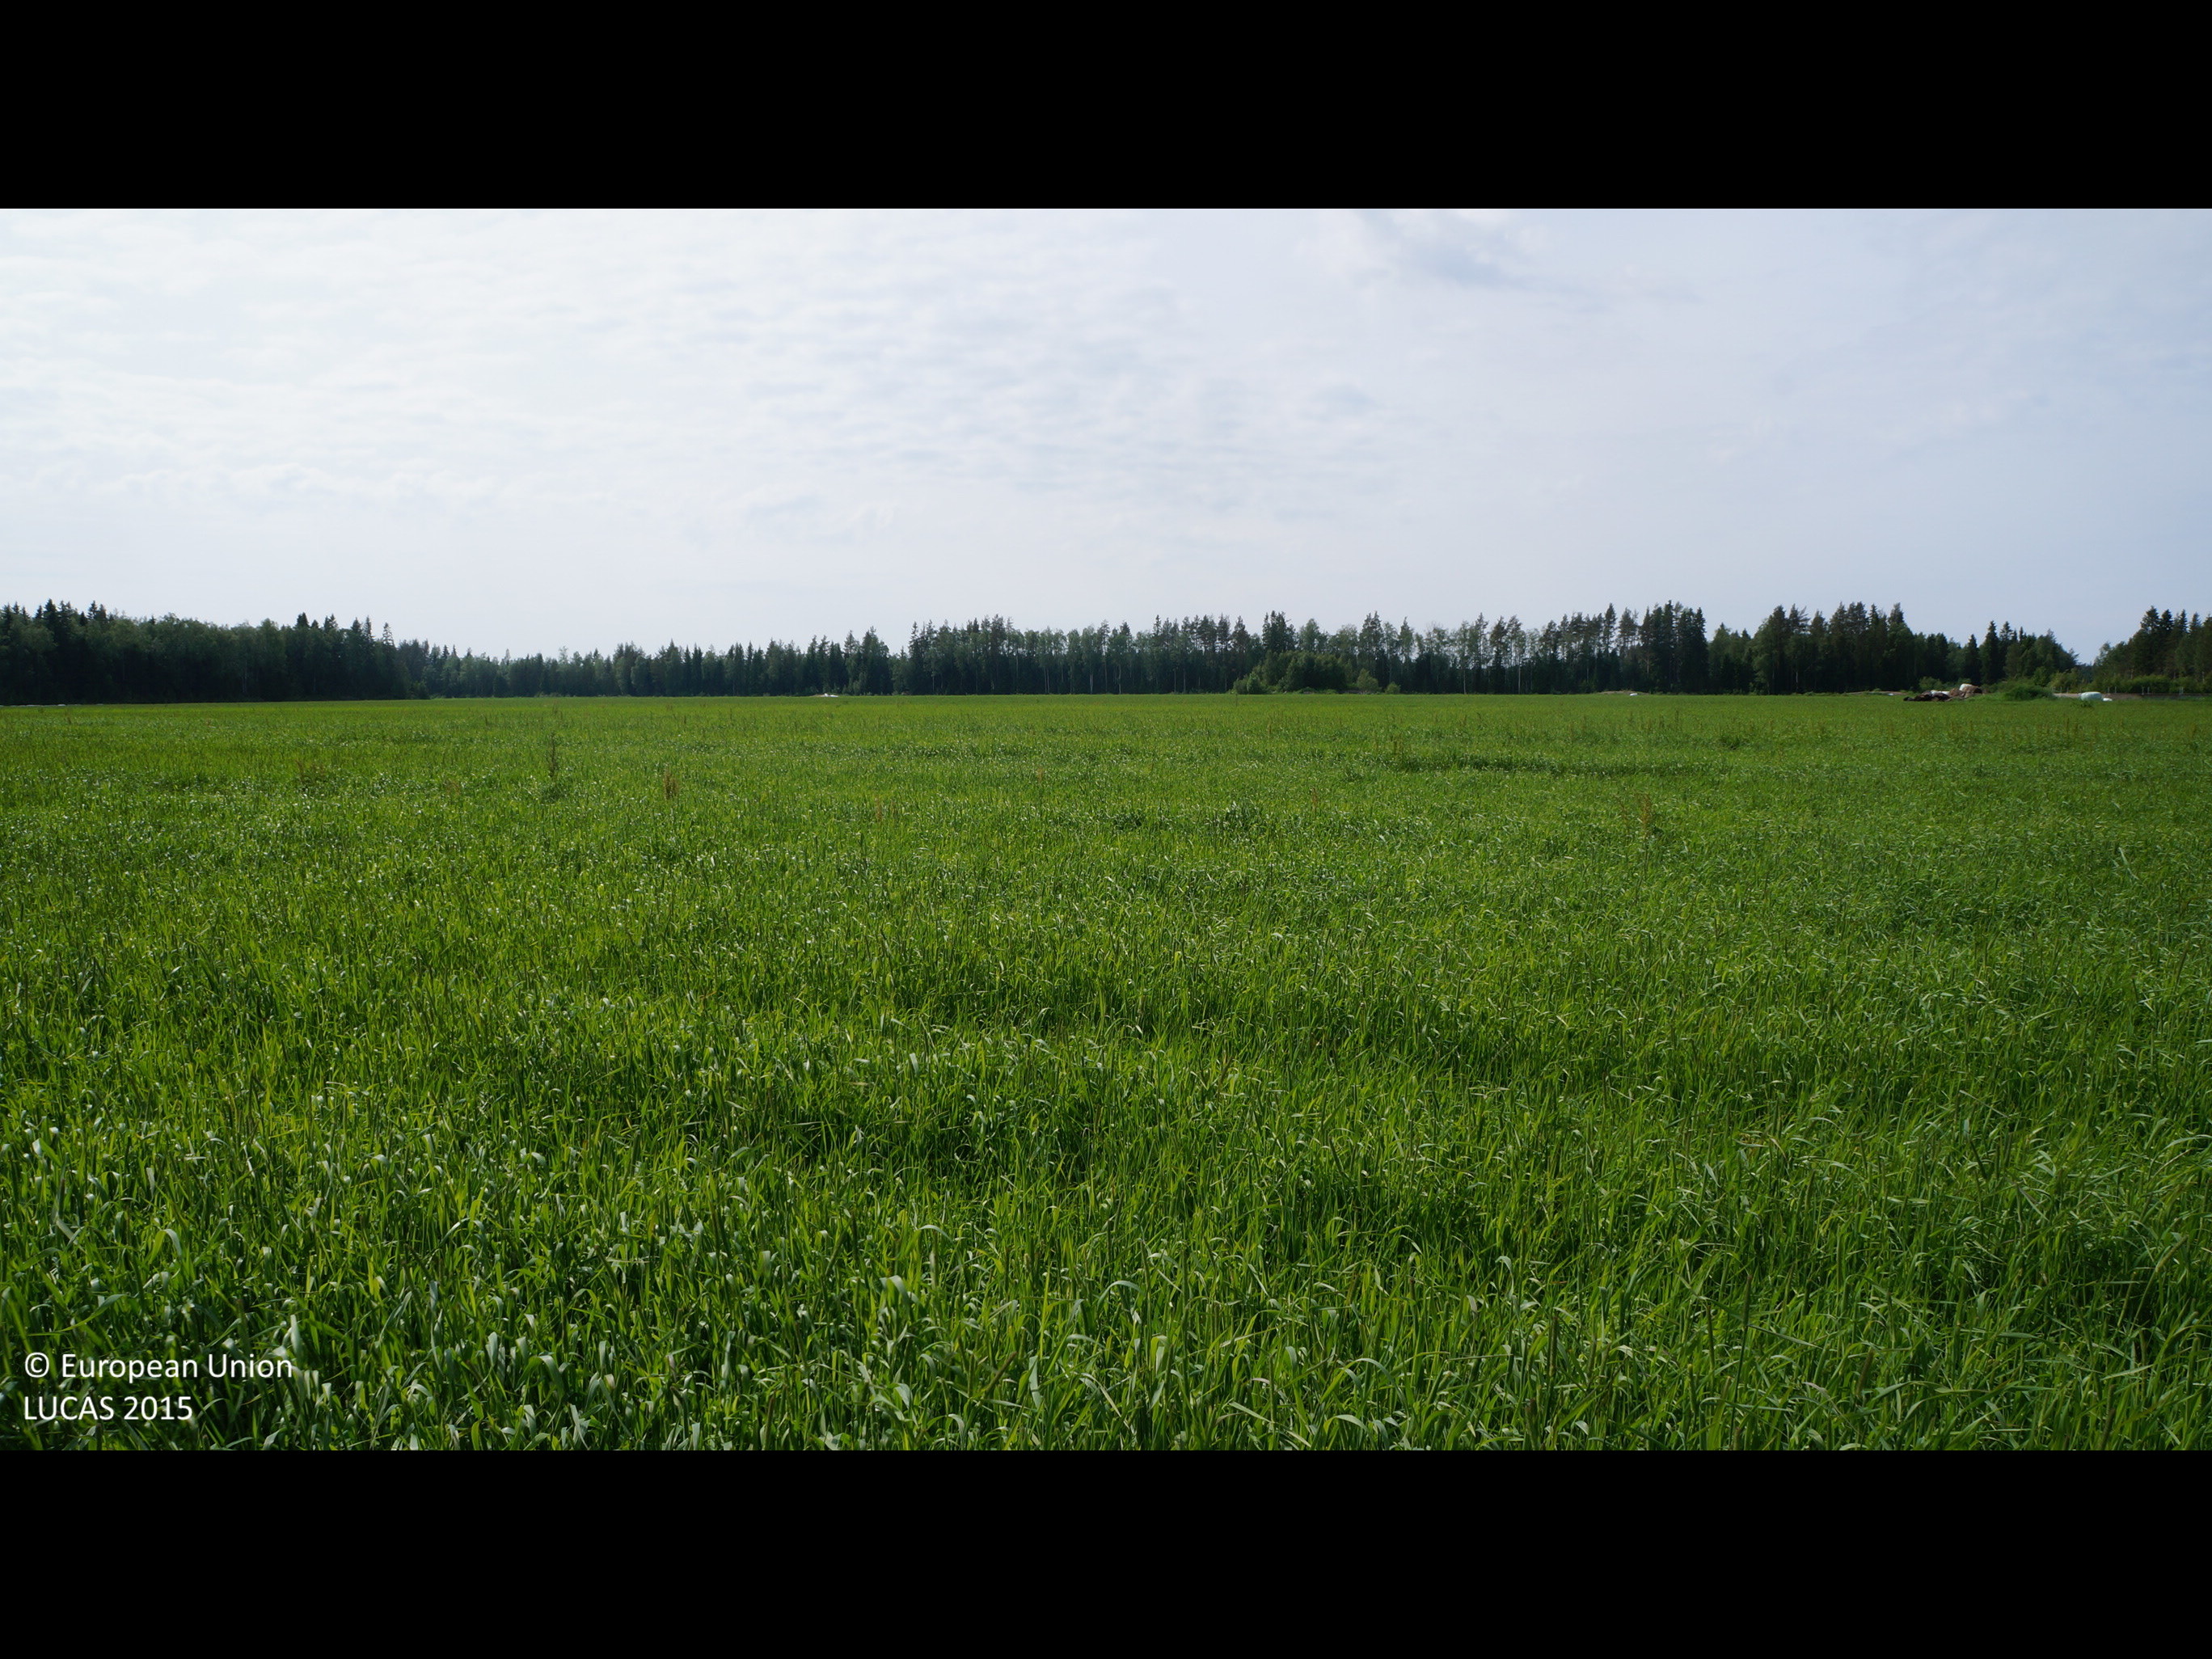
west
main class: Cropland
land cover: Temporary grasslands
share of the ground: > 75 %
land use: Agriculture (excluding fallow land and kitchen gardens)
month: June
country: FI
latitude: 64.1861
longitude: 23.9142
